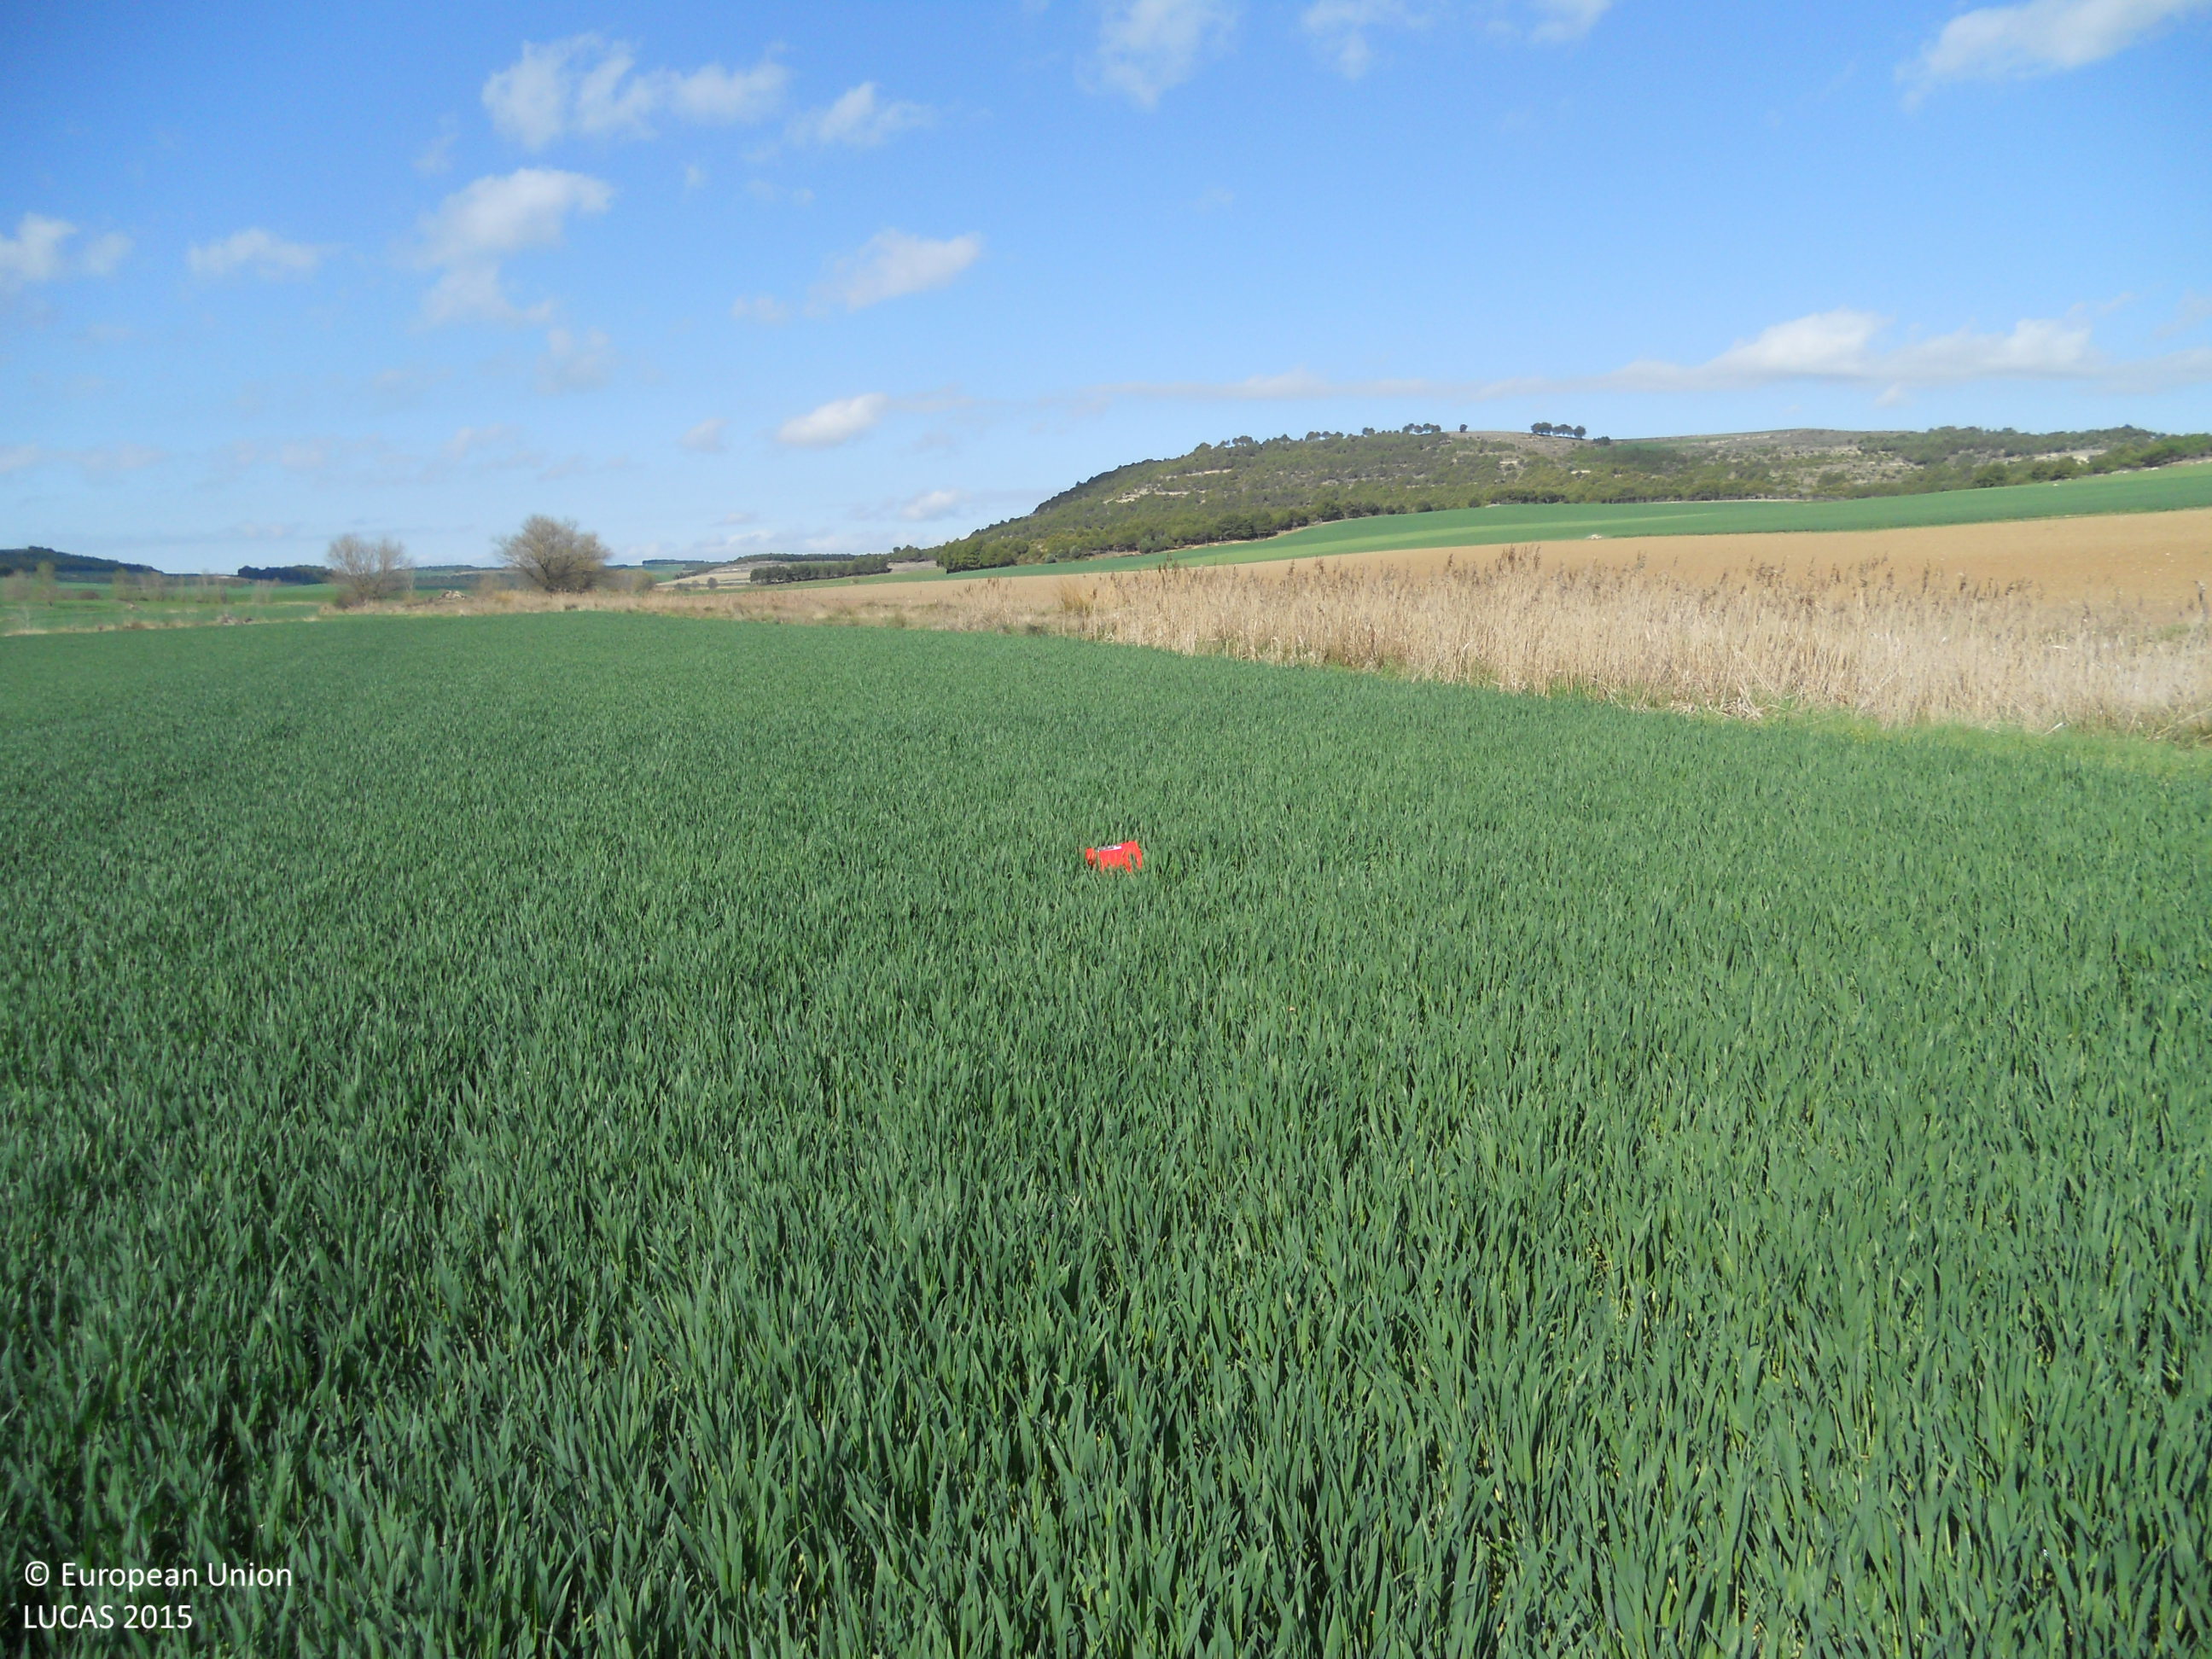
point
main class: Cropland
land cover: Common wheat
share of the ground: > 75 %
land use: Agriculture (excluding fallow land and kitchen gardens)
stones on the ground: < 10 %
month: April
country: ES
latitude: 42.1978
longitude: -4.3228
